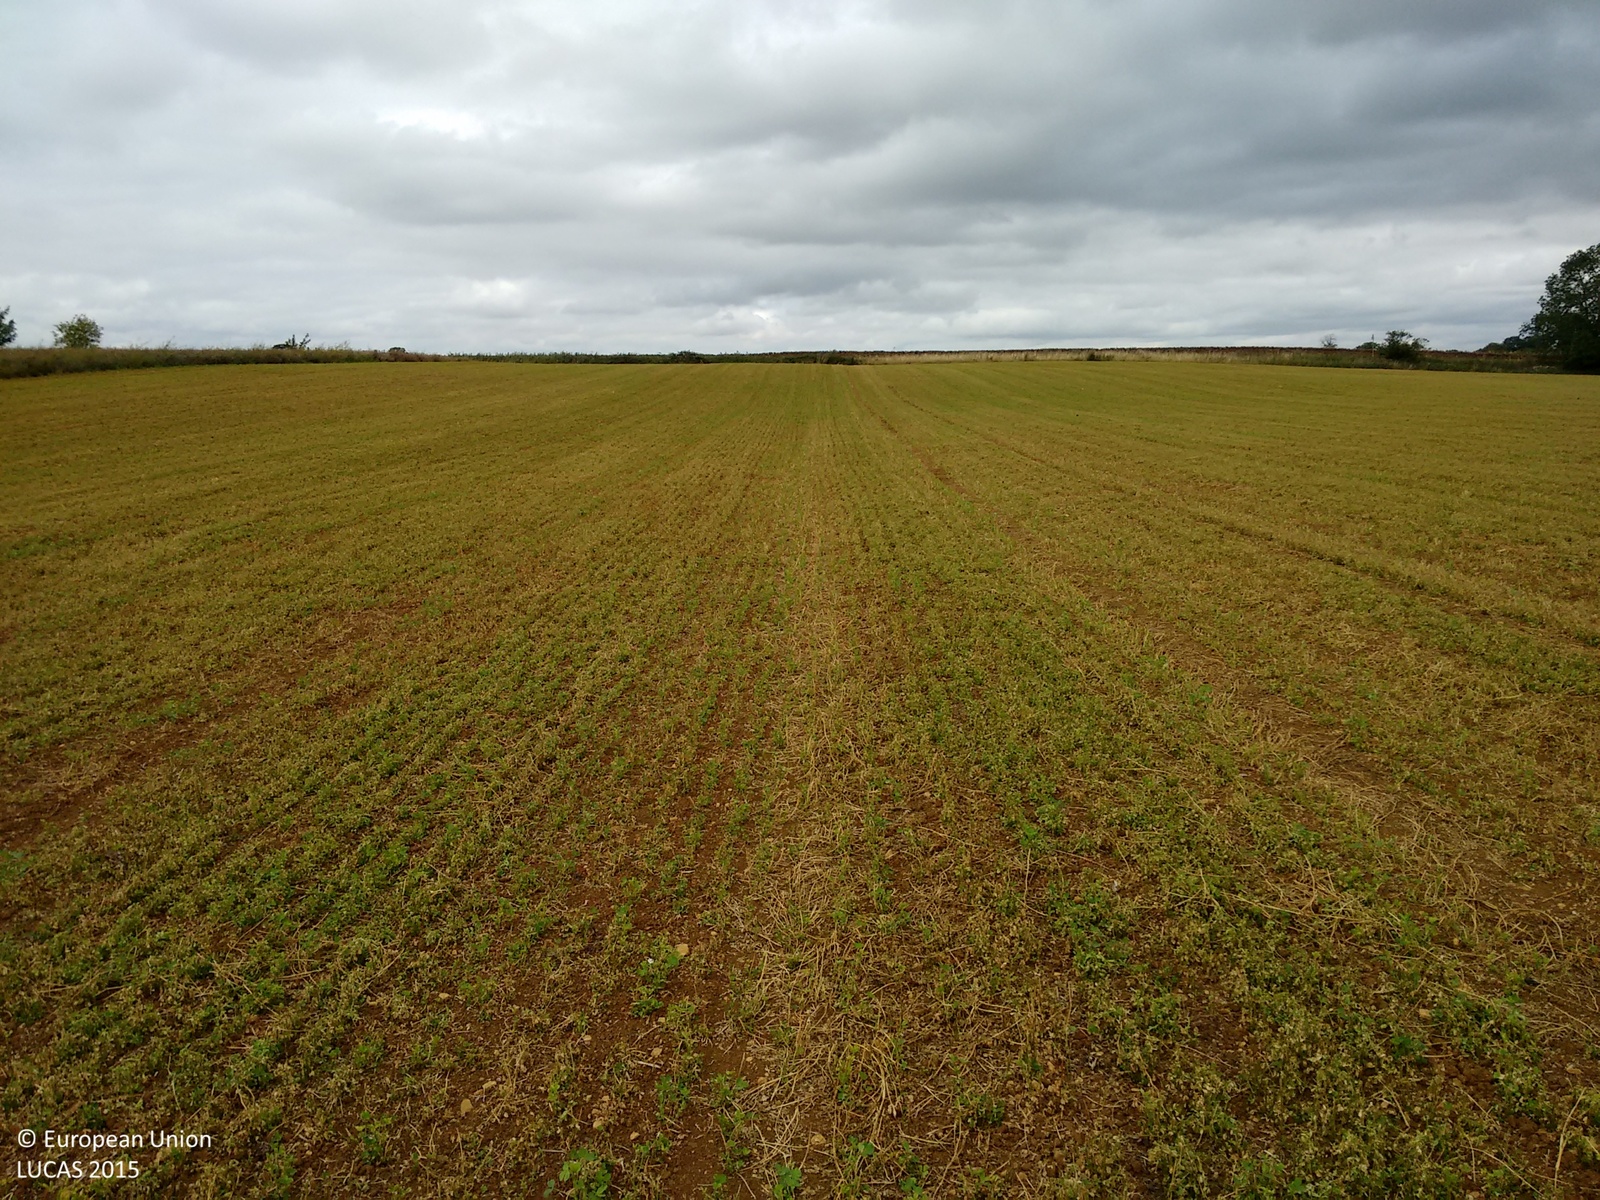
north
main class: Cropland
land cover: Dry pulses
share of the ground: 10 - 25 %
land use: Agriculture (excluding fallow land and kitchen gardens)
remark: Harvested field
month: August
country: GB
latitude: 52.2933
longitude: -0.8780
